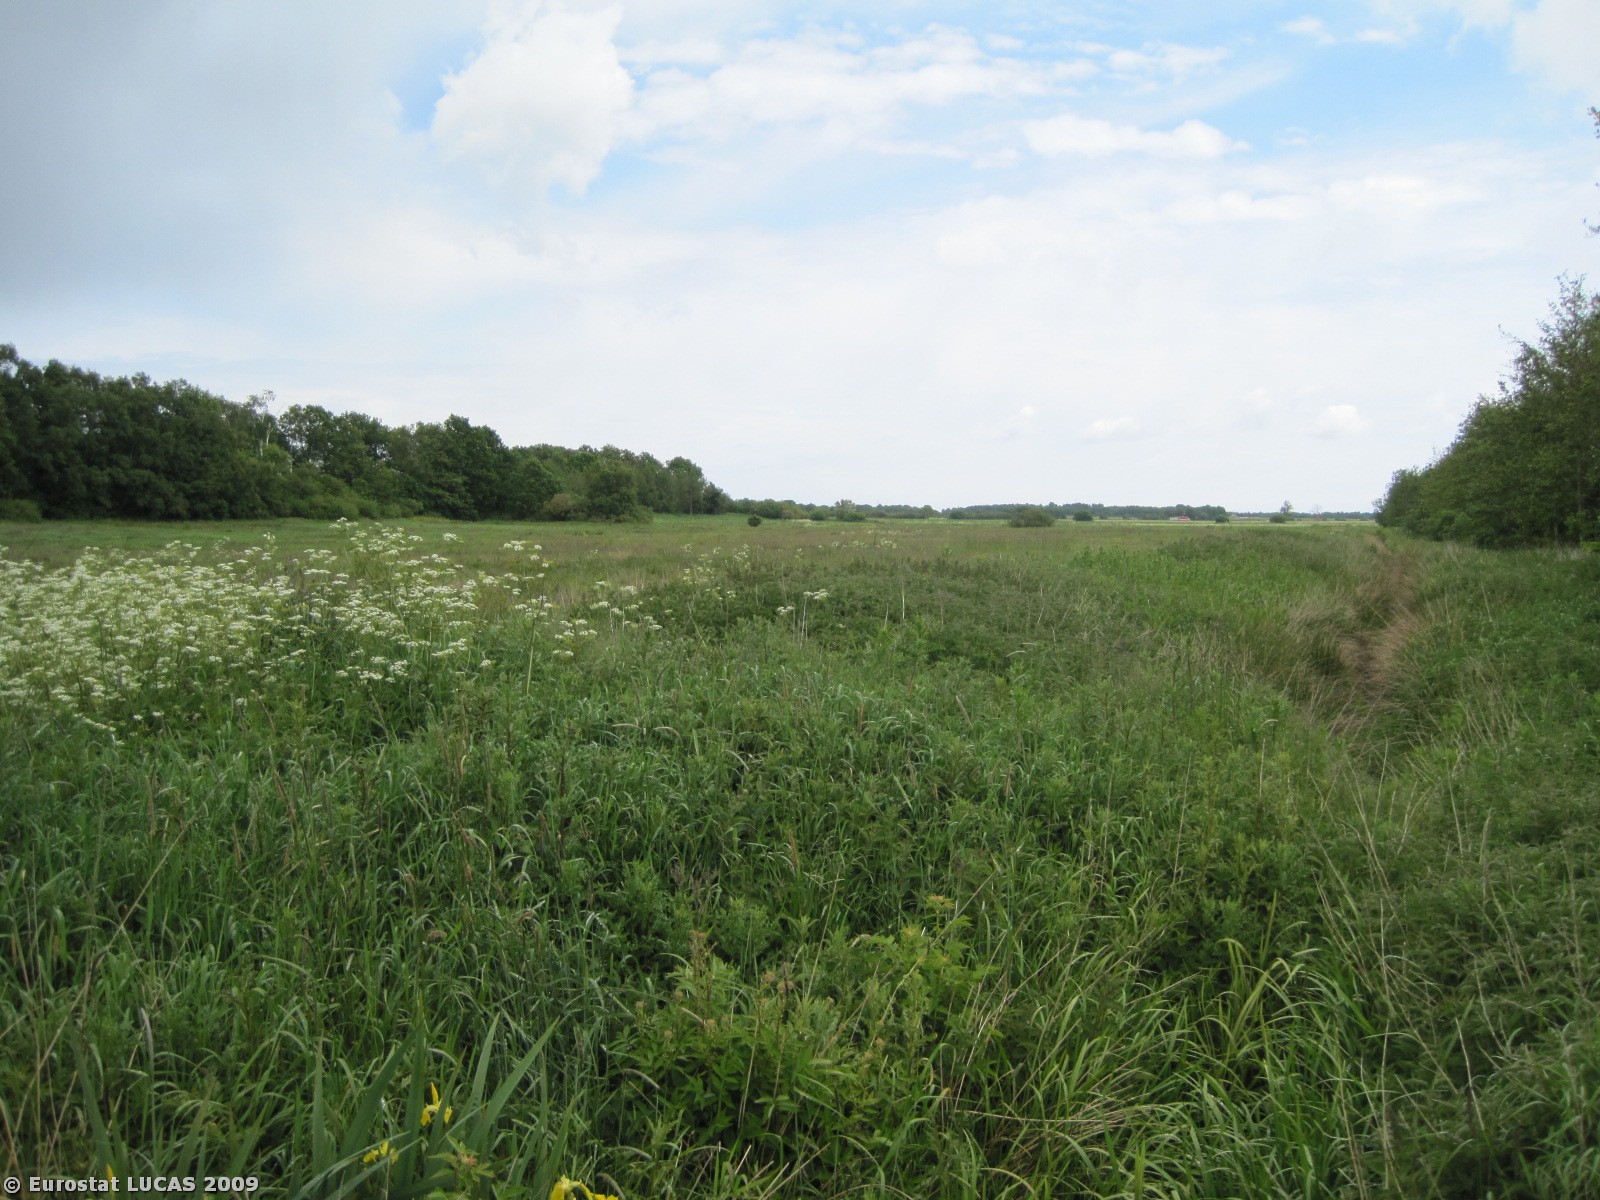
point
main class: Grassland
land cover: Grassland without tree/shrub cover
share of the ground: > 75 %
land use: Agriculture (excluding fallow land and kitchen gardens)
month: June
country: DK
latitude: 57.0503
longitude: 10.2798
